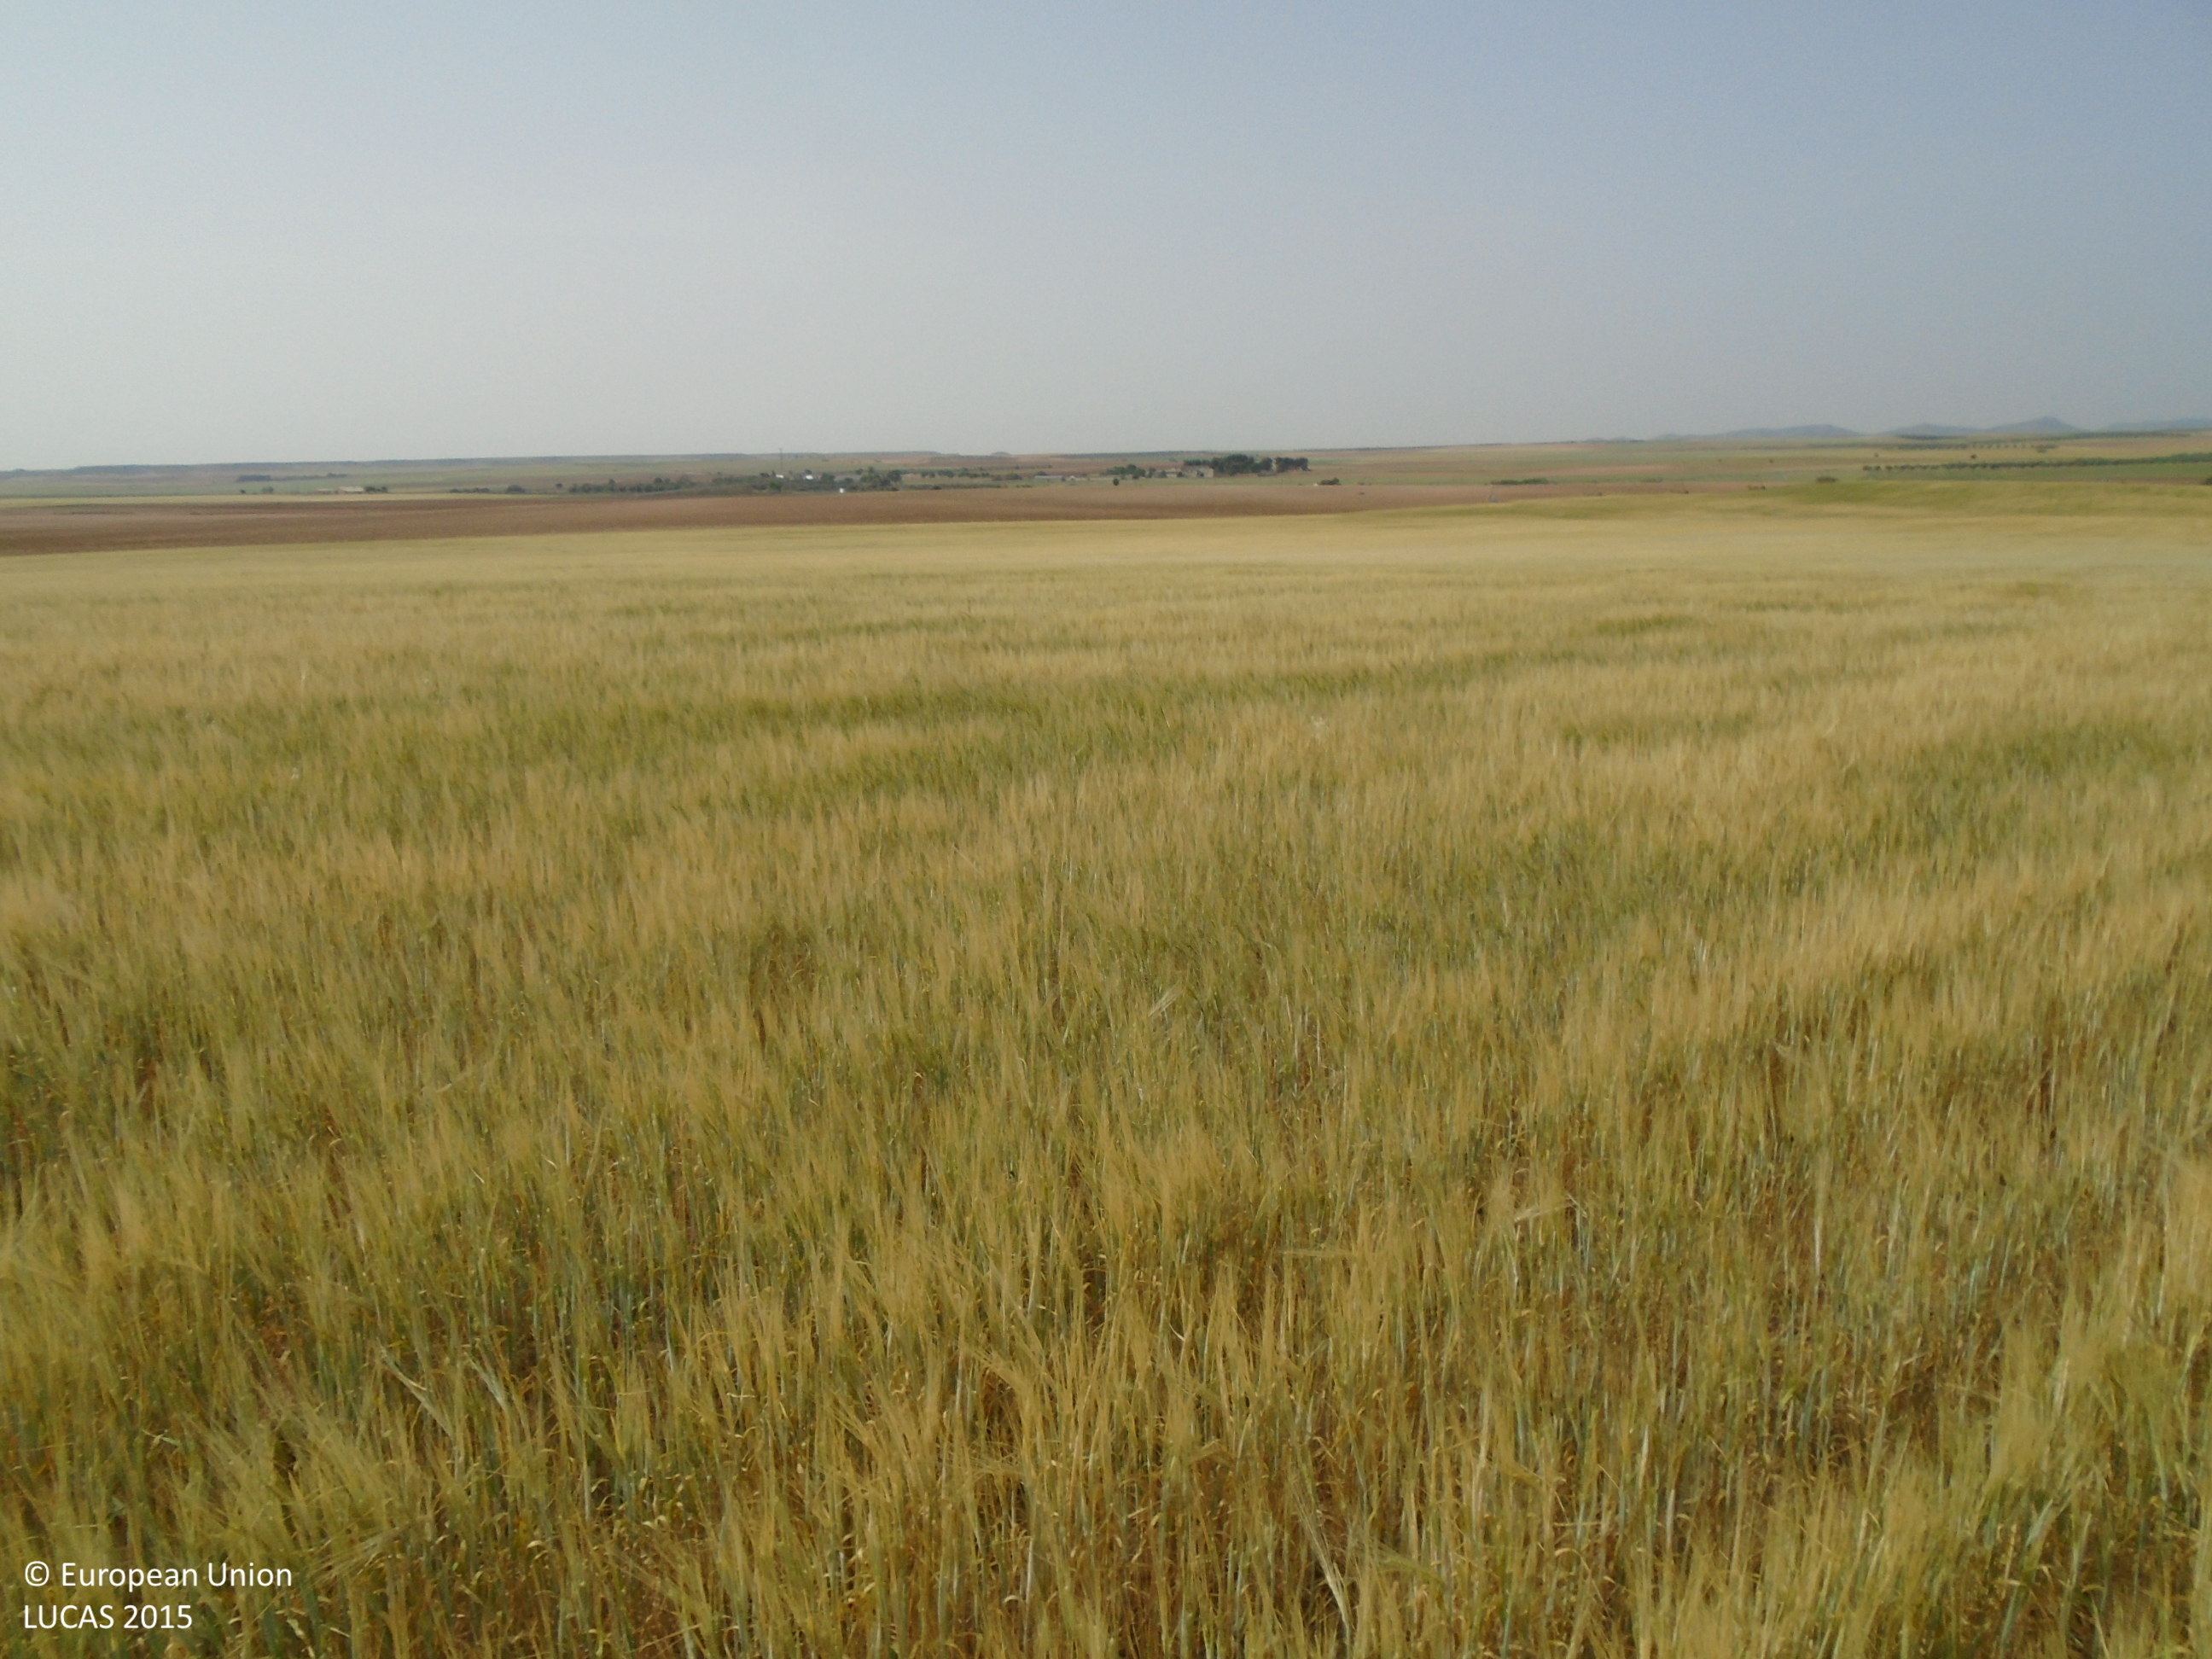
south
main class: Cropland
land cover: Barley
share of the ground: > 75 %
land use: Agriculture (excluding fallow land and kitchen gardens)
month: May
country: ES
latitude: 39.7905
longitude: -3.6091
